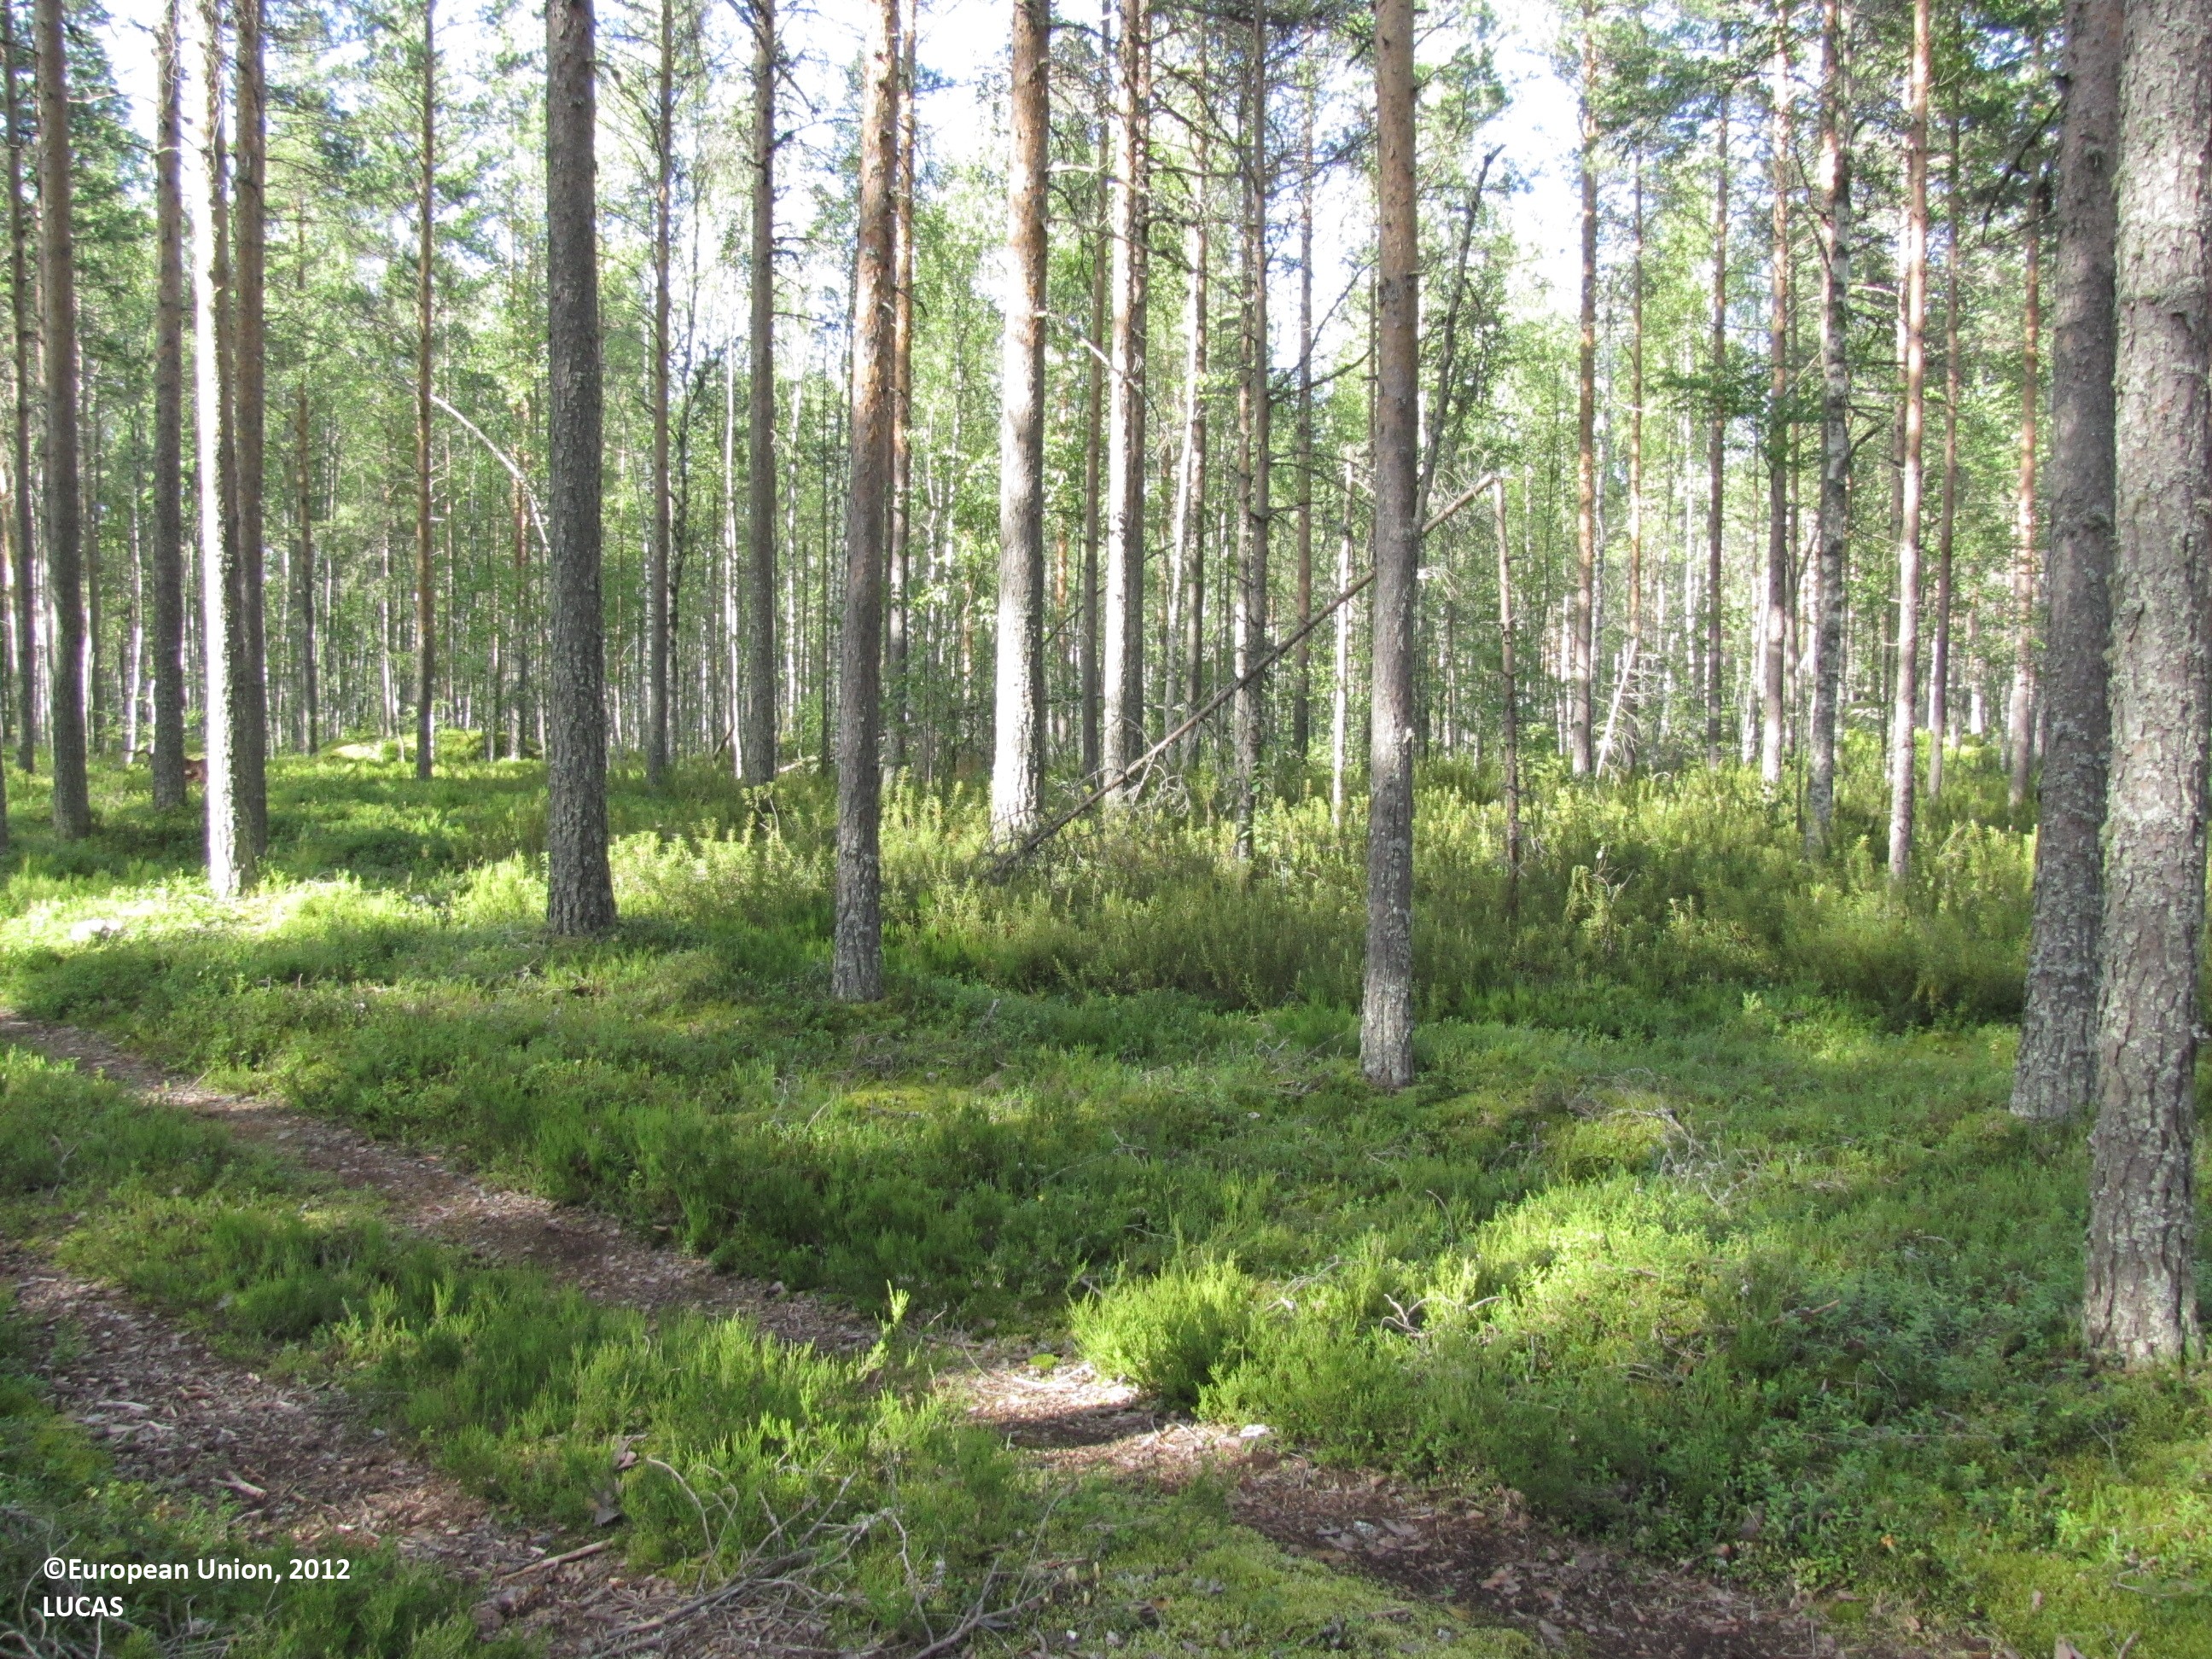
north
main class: Woodland
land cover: Pine dominated coniferous woodland
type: boreal forest
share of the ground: > 75 %
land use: Forestry
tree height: > 5 m
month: July
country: FI
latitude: 62.3625
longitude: 23.1486
